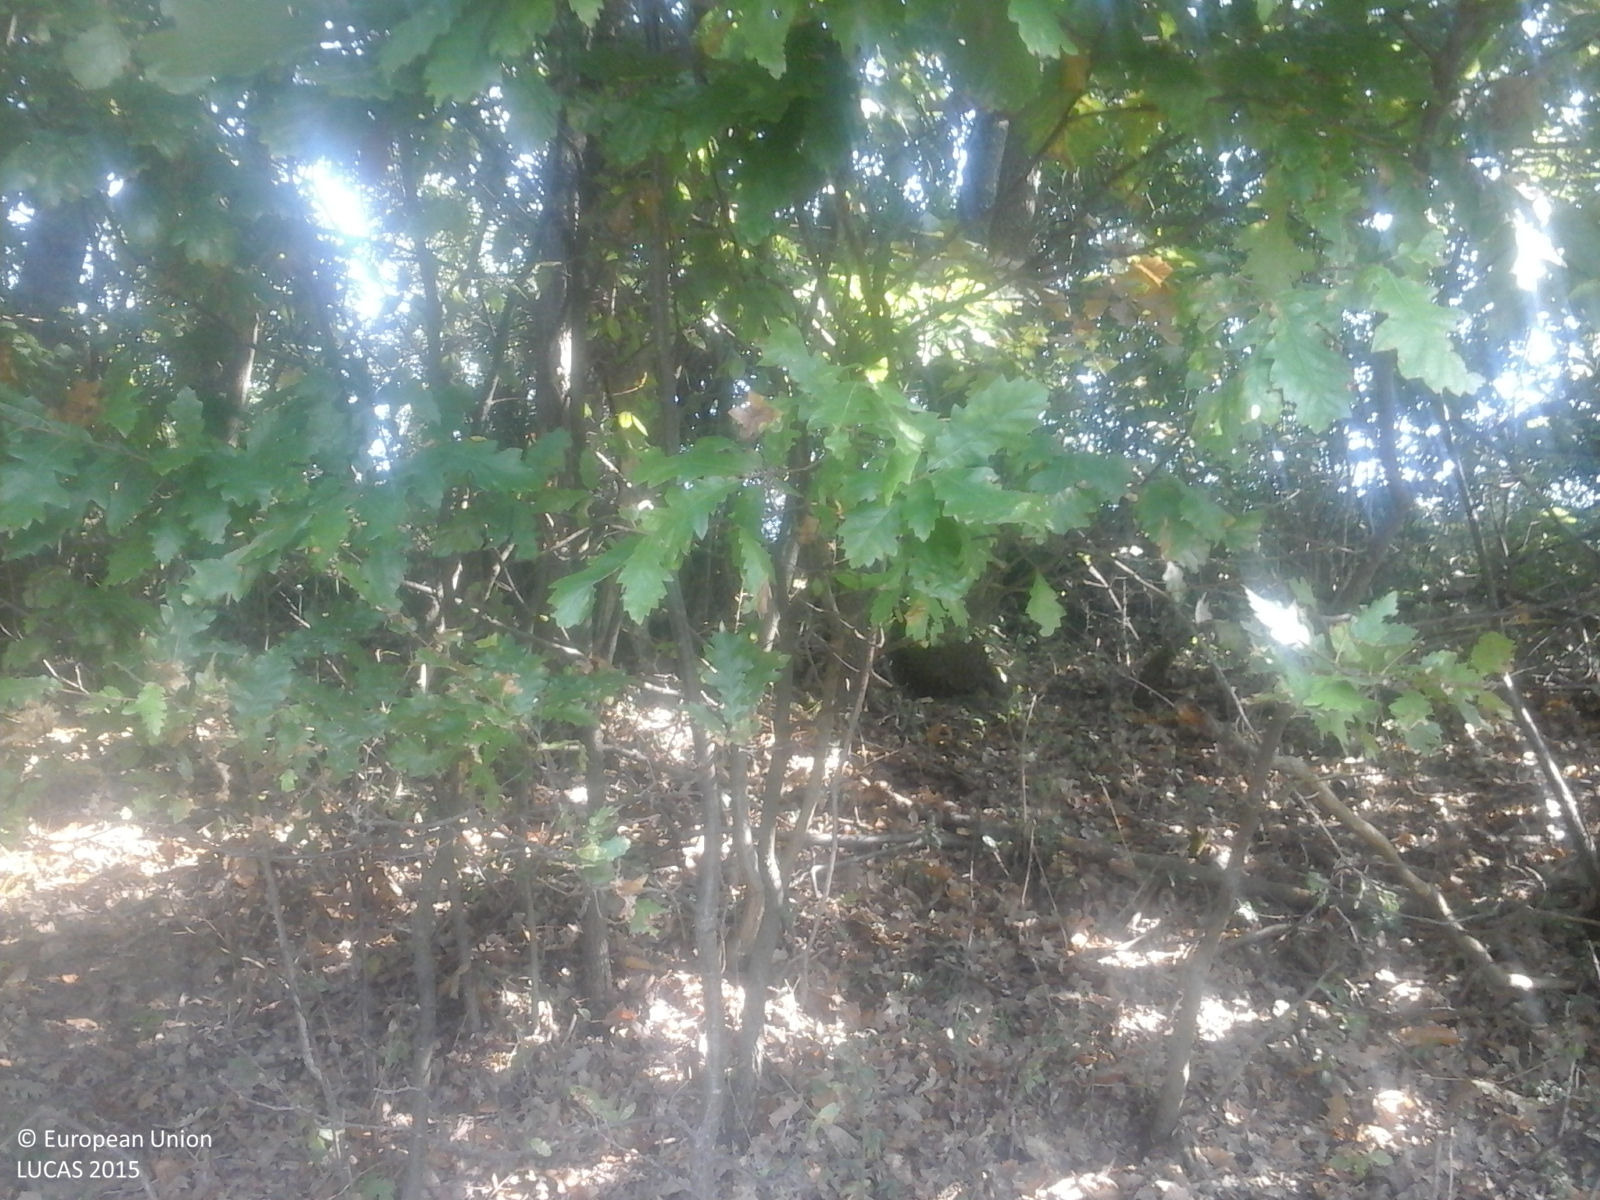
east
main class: Woodland
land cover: Broadleaved woodland
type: acidophilous oak and oak-birch forest
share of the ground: > 75 %
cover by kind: broadleaved forest trees 100 %
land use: Forestry
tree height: > 5 m
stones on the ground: 10 - 25 %
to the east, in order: Broadleaved woodland; Ditches and canals; Broadleaved woodland; Grassland without tree/shrub cover; Spontaneously vegetated surfaces; Grassland without tree/shrub cover; Tracks; Grassland without tree/shrub cover; Abandoned hedges; Grass margins; Tracks; Grass margins; Shrubland with sparse tree cover; Broadleaved woodland
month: September
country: RO
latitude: 45.8869
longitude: 22.5089
